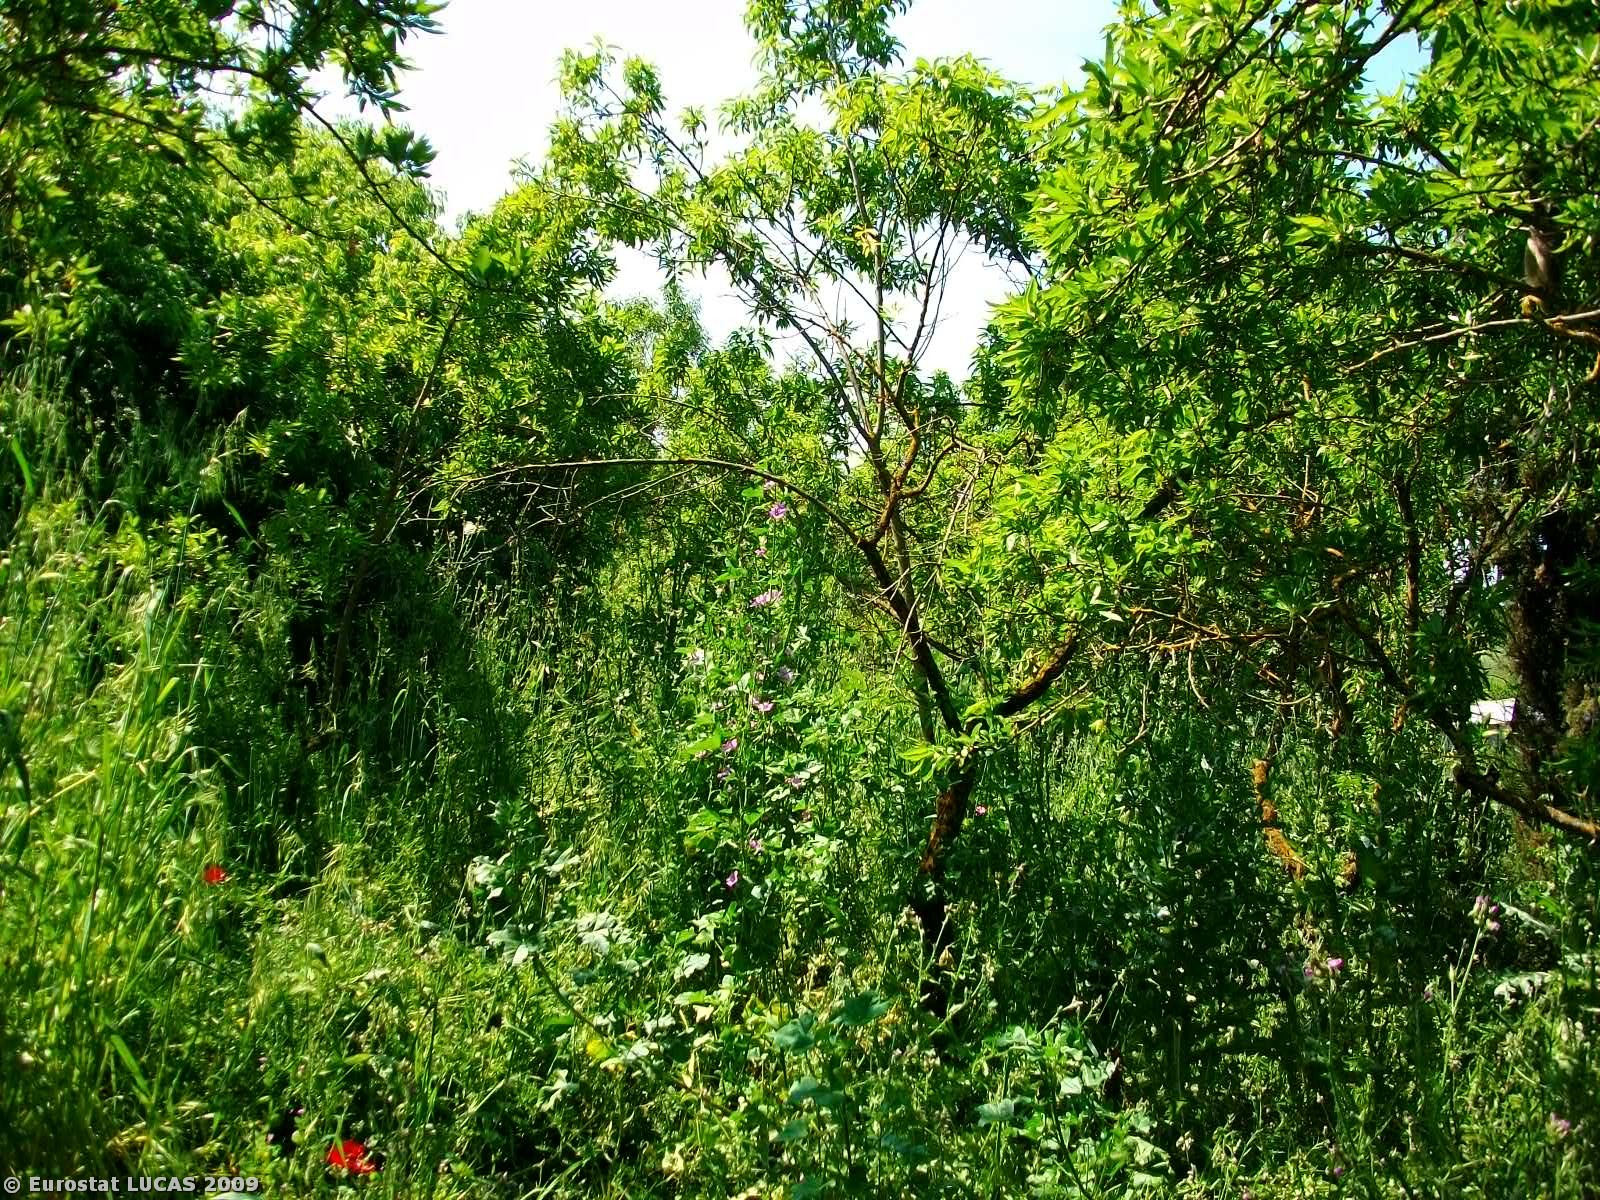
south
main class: Cropland
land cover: Nuts trees
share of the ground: 50 - 75 %
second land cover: Grassland with sparse tree/shrub cover
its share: > 75 %
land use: Agriculture (excluding fallow land and kitchen gardens)
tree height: > 5 m
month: May
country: GR
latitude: 39.3772
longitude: 22.7475
